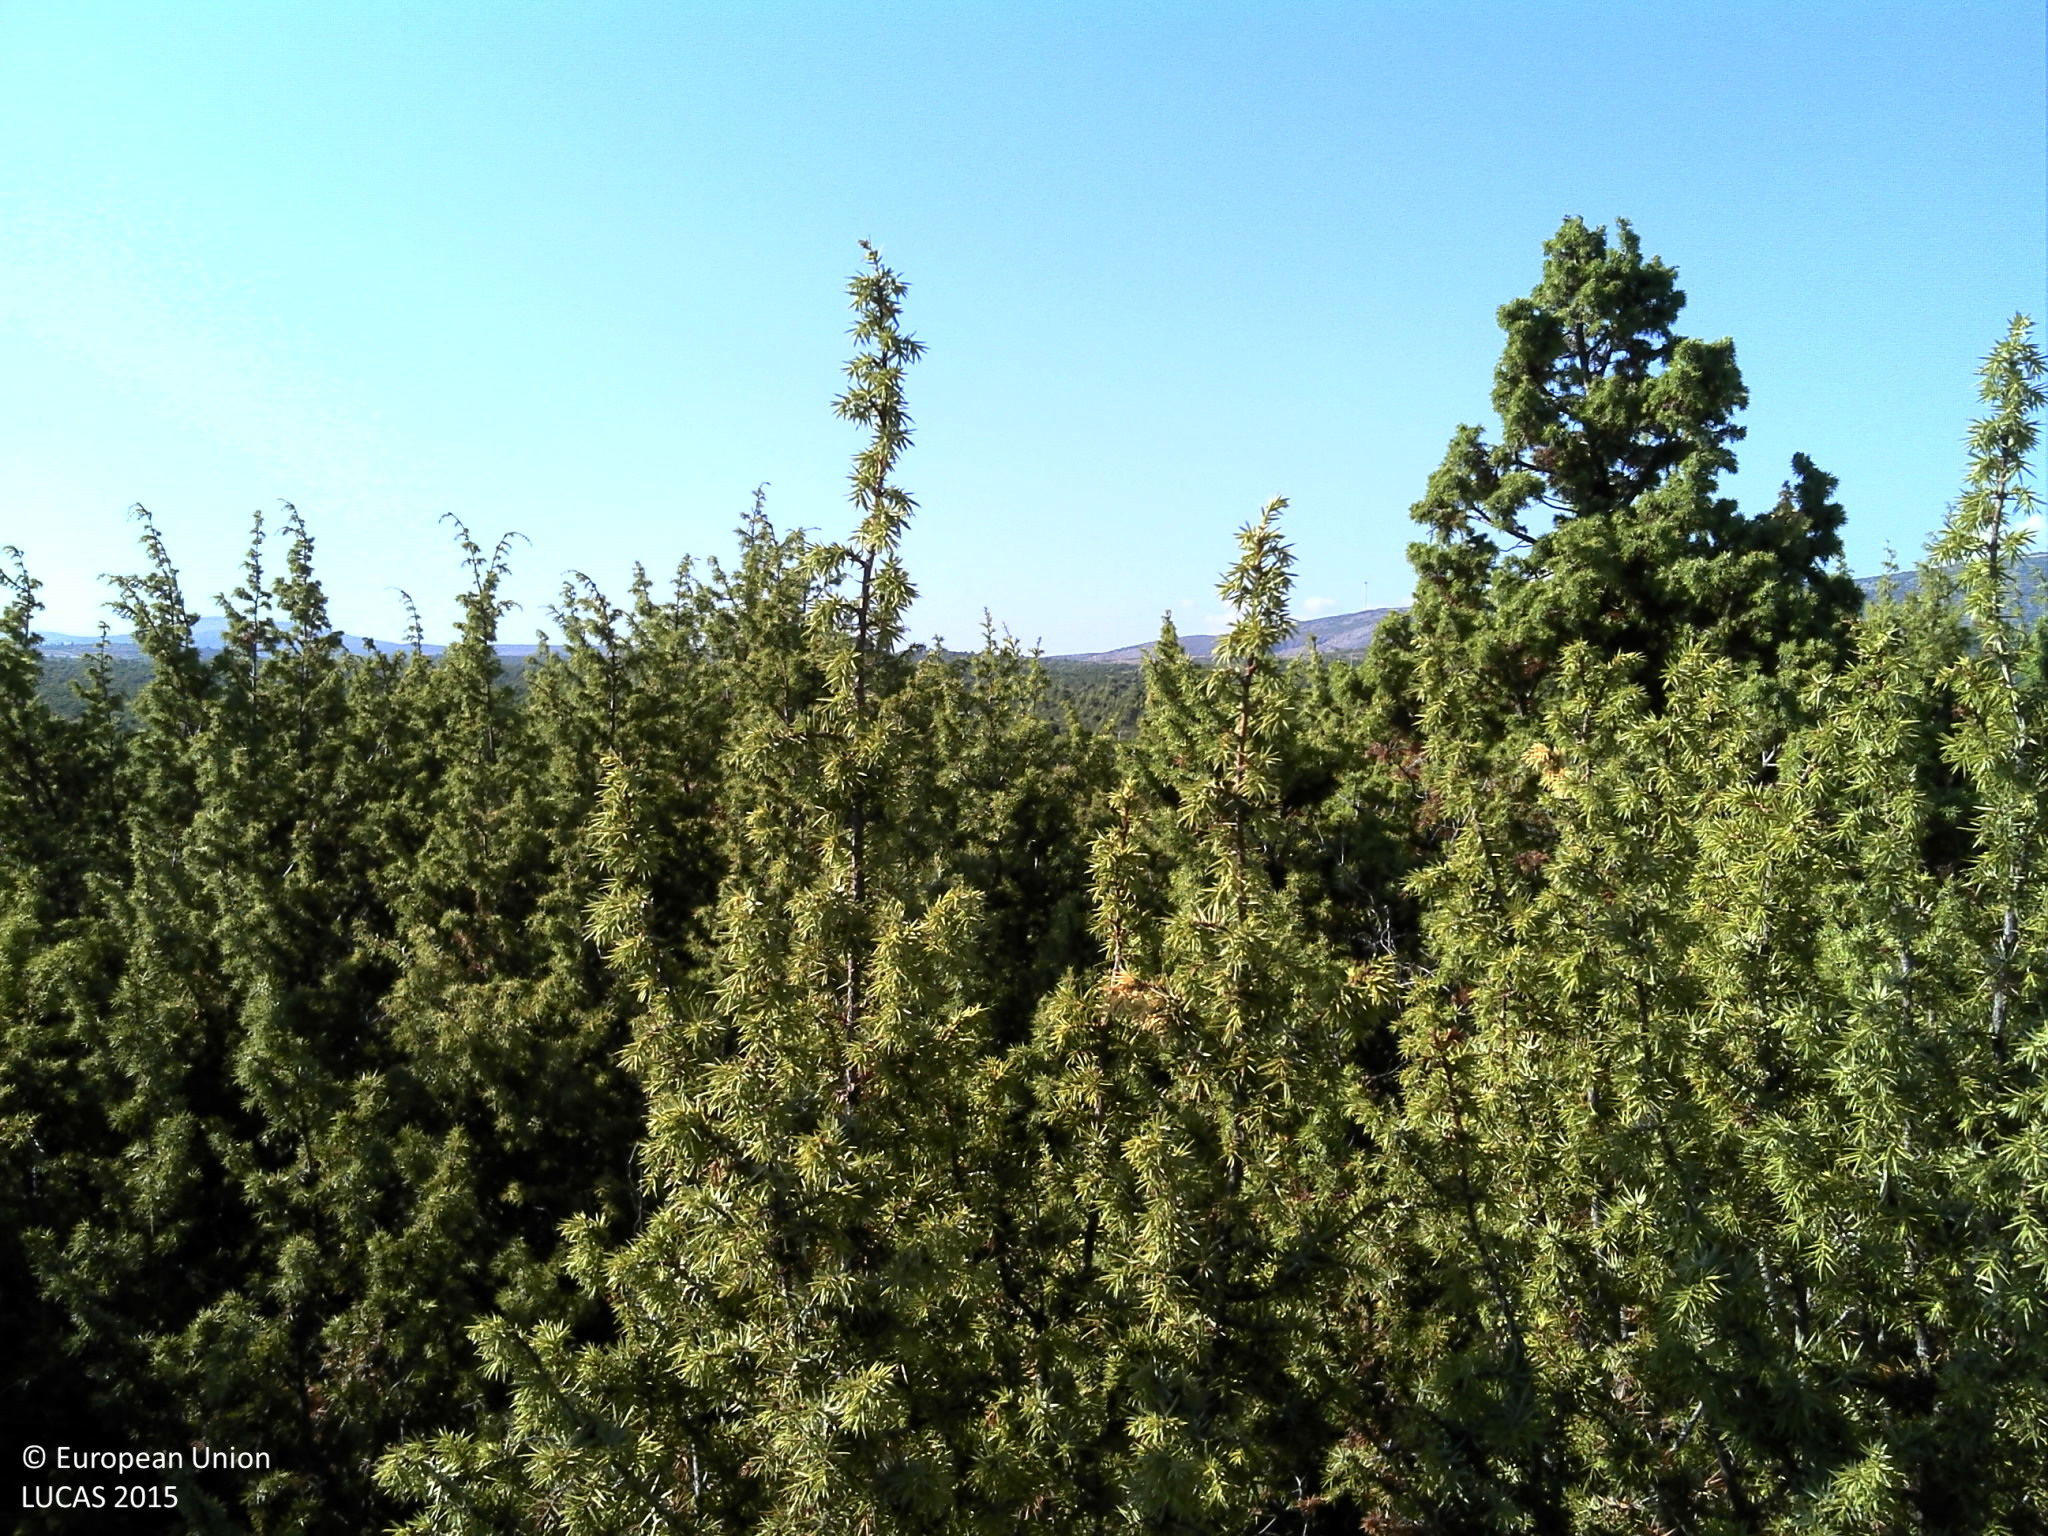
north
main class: Shrubland
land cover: Shrubland without tree cover
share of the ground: 50 - 75 %
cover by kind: shrubs 60 %, herbaceous plants 20 %, consolidated bare surface 10 %, unconsolidated bare surface 10 %
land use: Semi-natural and natural areas not in use
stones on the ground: < 10 %
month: July
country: HR
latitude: 43.6673
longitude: 16.0554
